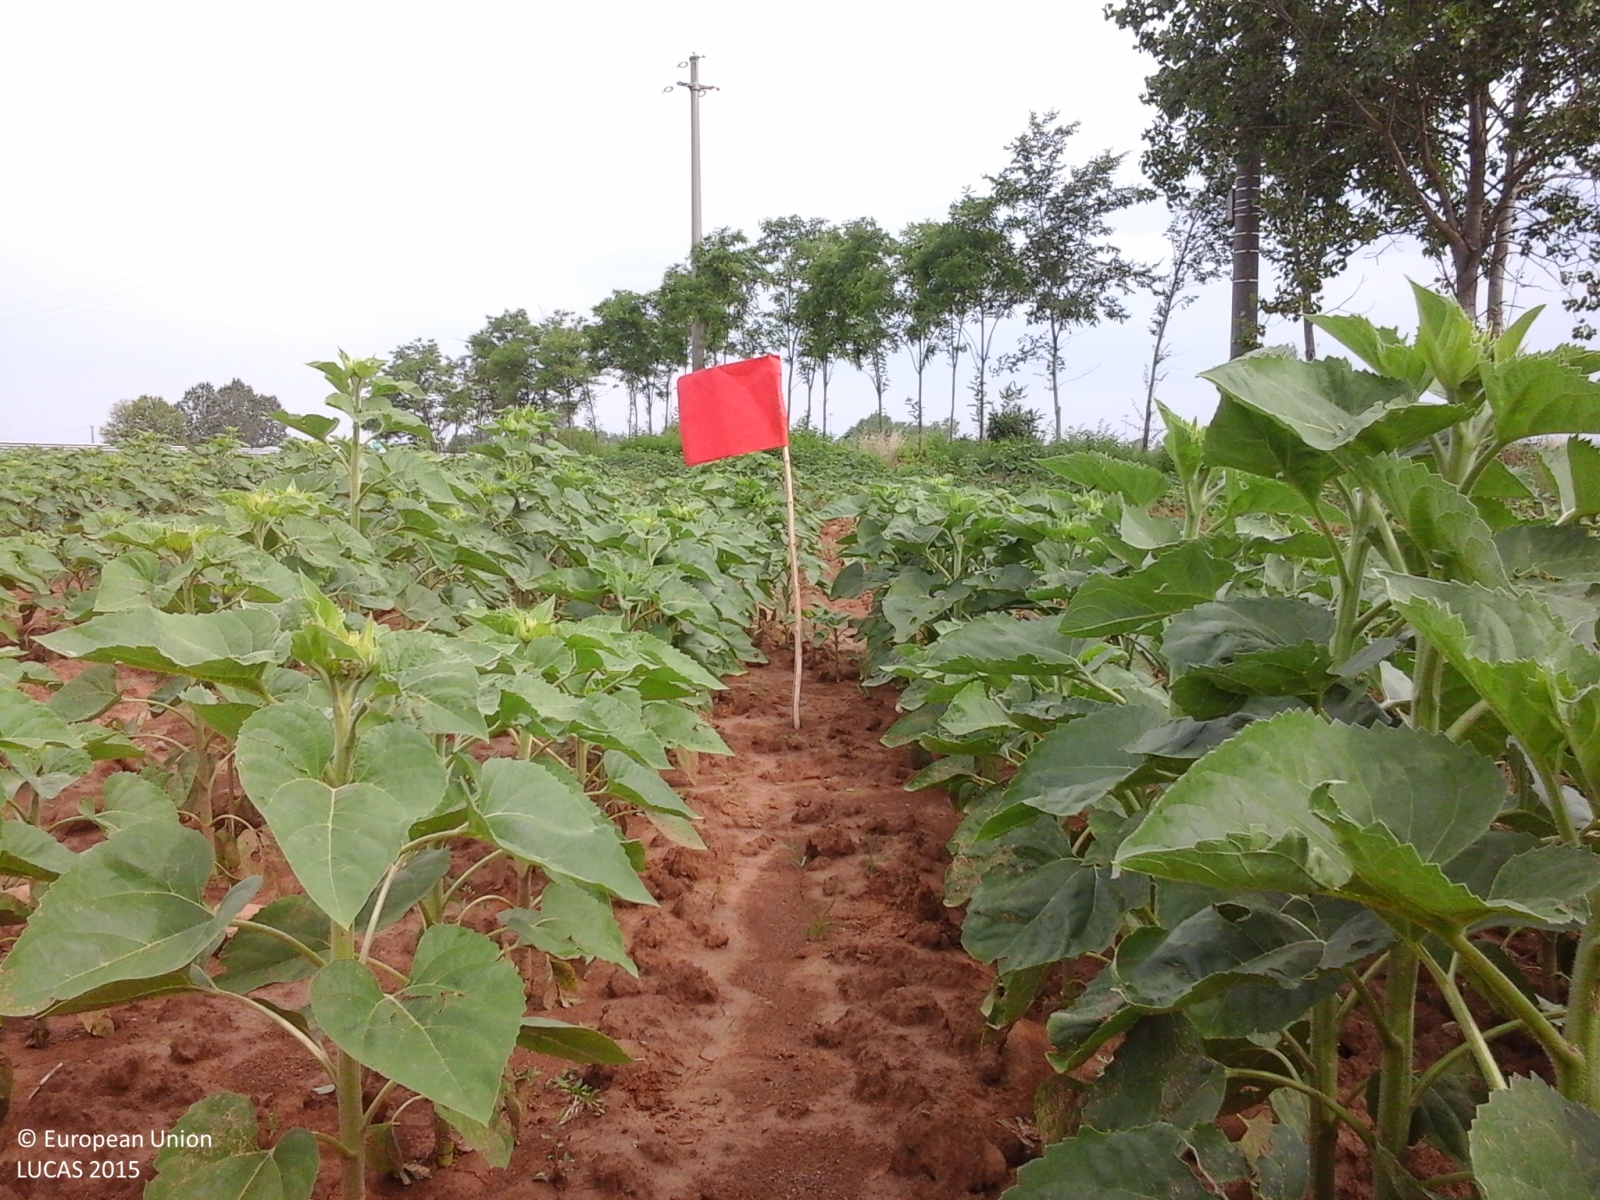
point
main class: Cropland
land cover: Sunflower
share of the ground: 50 - 75 %
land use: Agriculture (excluding fallow land and kitchen gardens)
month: June
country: IT
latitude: 44.8100
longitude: 8.5993
